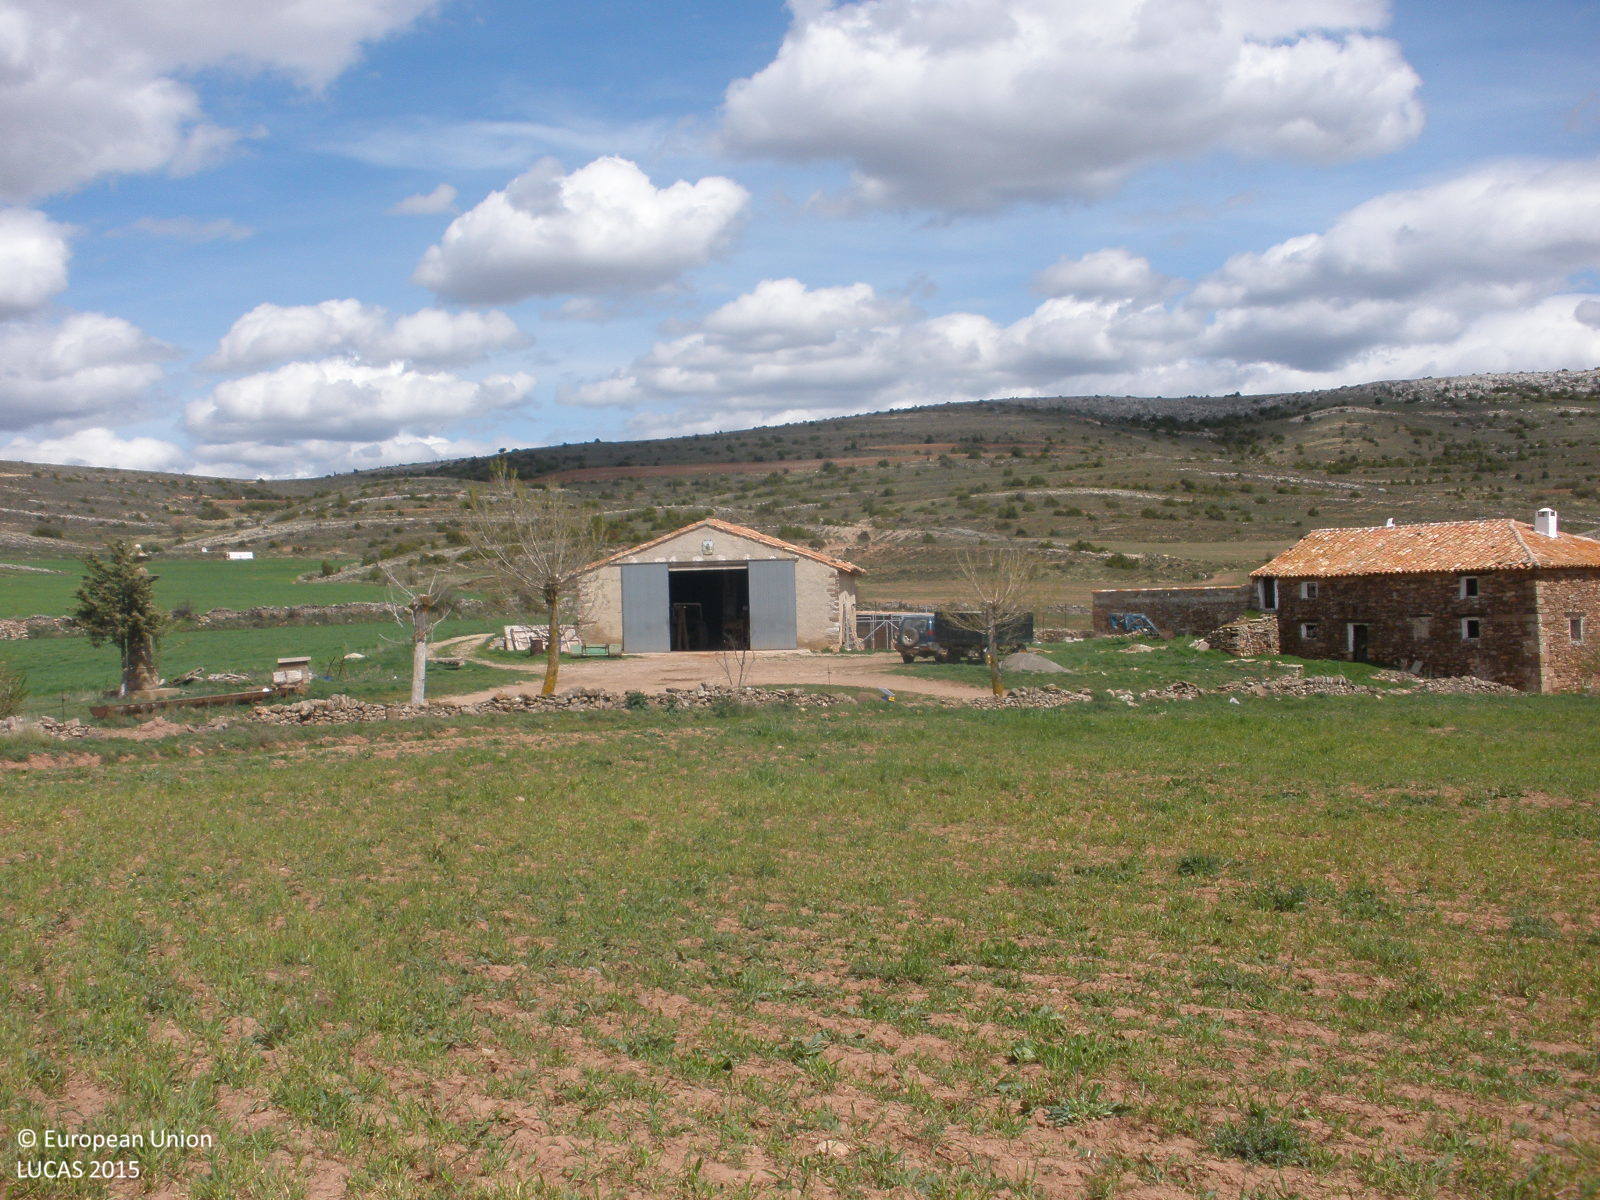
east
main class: Grassland
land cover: Spontaneously vegetated surfaces
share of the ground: 50 - 75 %
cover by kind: herbaceous plants 50 %, unconsolidated bare surface 50 %
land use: Agriculture (excluding fallow land and kitchen gardens)
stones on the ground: < 10 %
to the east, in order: Spontaneously vegetated surfaces; Dry stone walls; Lines of trees; Tracks; Artificial constructions in urban areas; Grassland without tree/shrub cover; Tracks; Grassland with sparse tree/shrub cover; Tracks
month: April
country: ES
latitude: 40.4894
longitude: -0.8052
